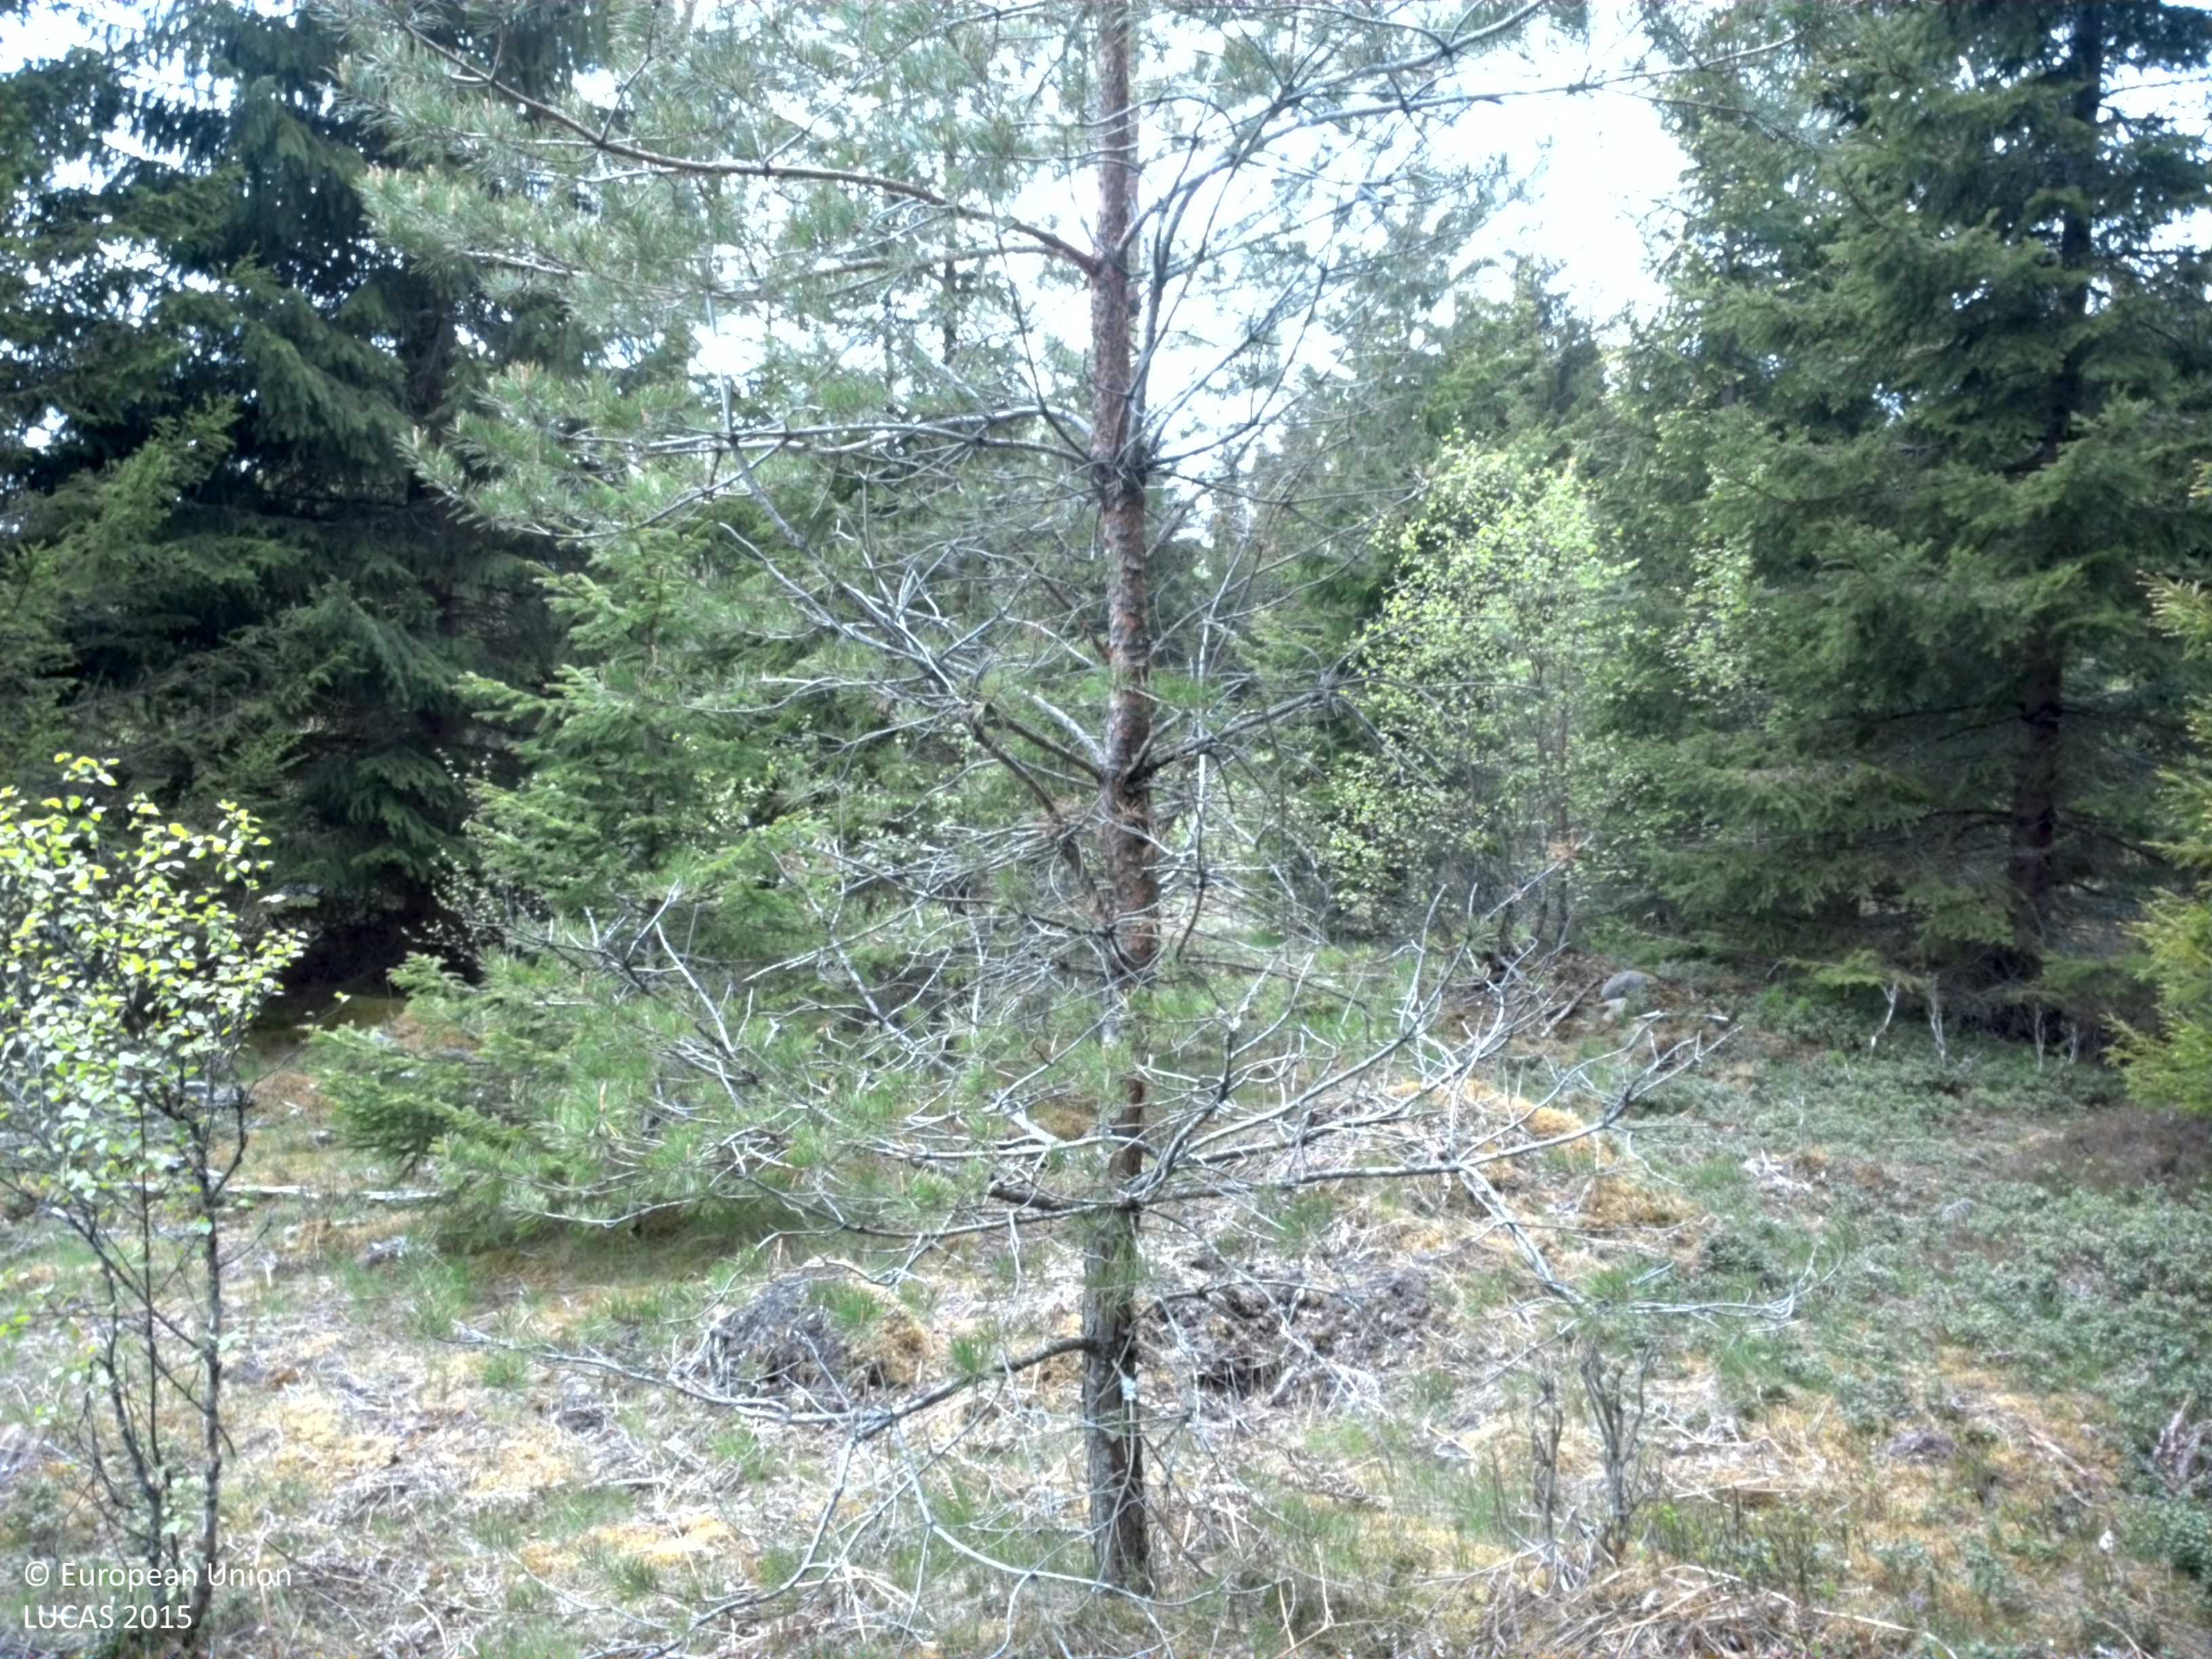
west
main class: Woodland
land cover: Spruce dominated coniferous woodland
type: boreal forest
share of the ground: 50 - 75 %
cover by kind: coniferous forest trees 50 %, shrubs 30 %, broadleaved forest trees 10 %, herbaceous plants 5 %, lichens and mosses 5 %
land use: Forestry
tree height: > 5 m
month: May
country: SE
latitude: 56.8933
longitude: 15.2014
